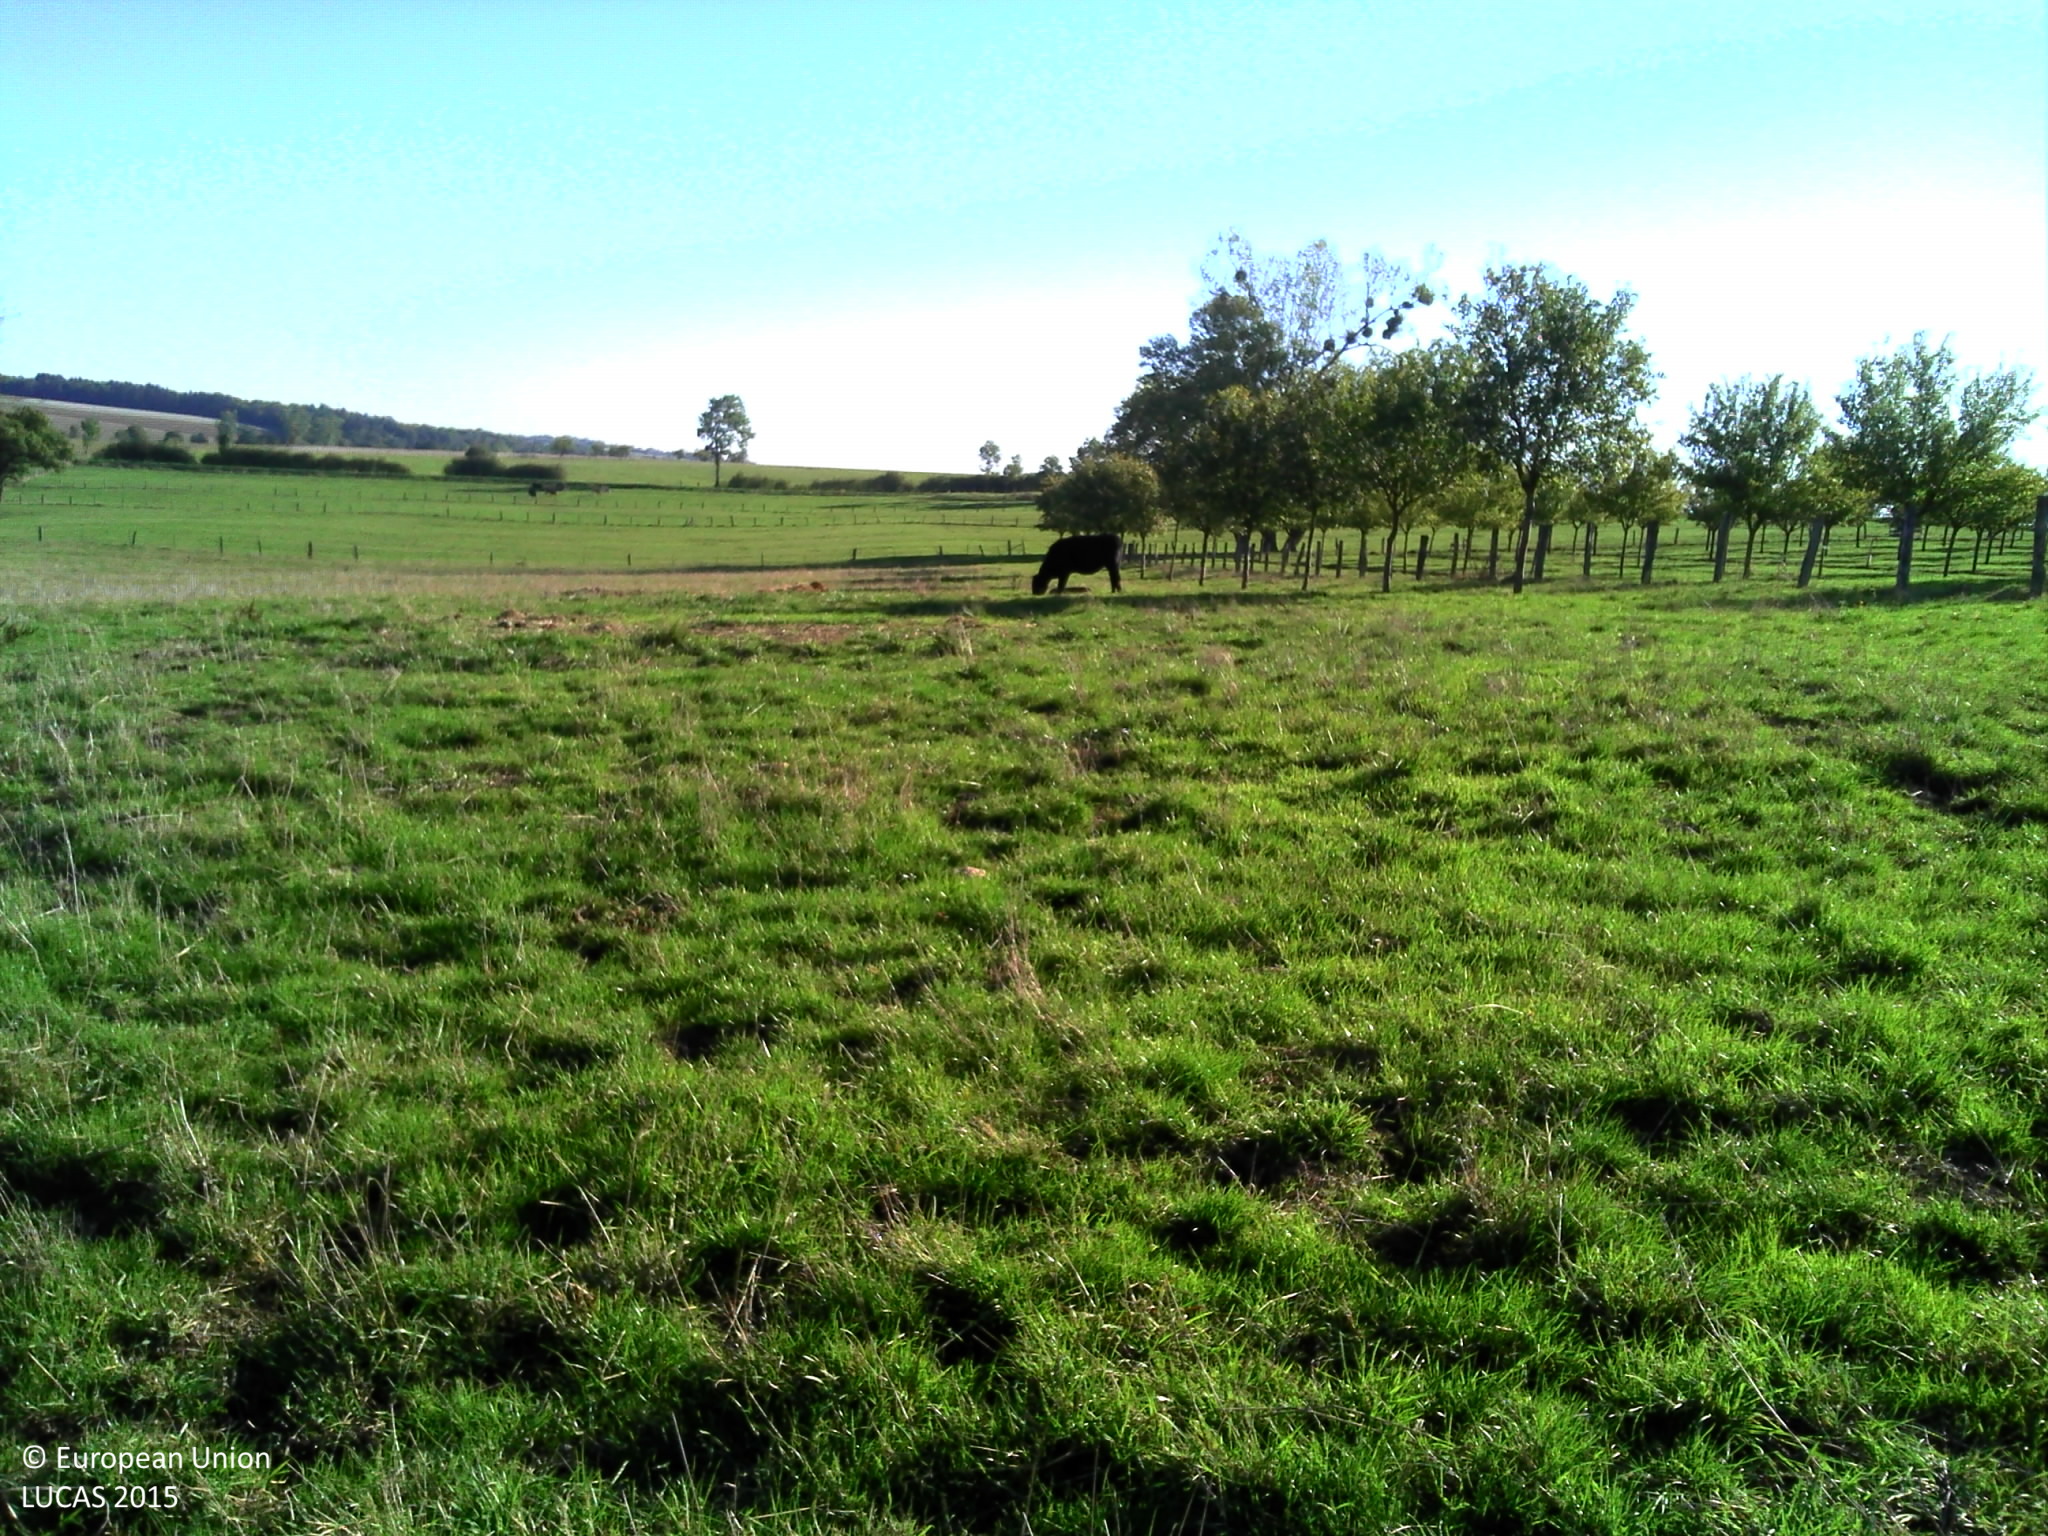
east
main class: Grassland
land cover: Grassland without tree/shrub cover
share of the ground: > 75 %
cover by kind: herbaceous plants 95 %, consolidated bare surface 5 %
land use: Agriculture (excluding fallow land and kitchen gardens)
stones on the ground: < 10 %
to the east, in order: Grassland without tree/shrub cover; Fences; Grassland without tree/shrub cover; Other fruit trees and berries; Grassland without tree/shrub cover; Fences; Grassland without tree/shrub cover
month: September
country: FR
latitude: 48.4256
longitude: 6.1217
